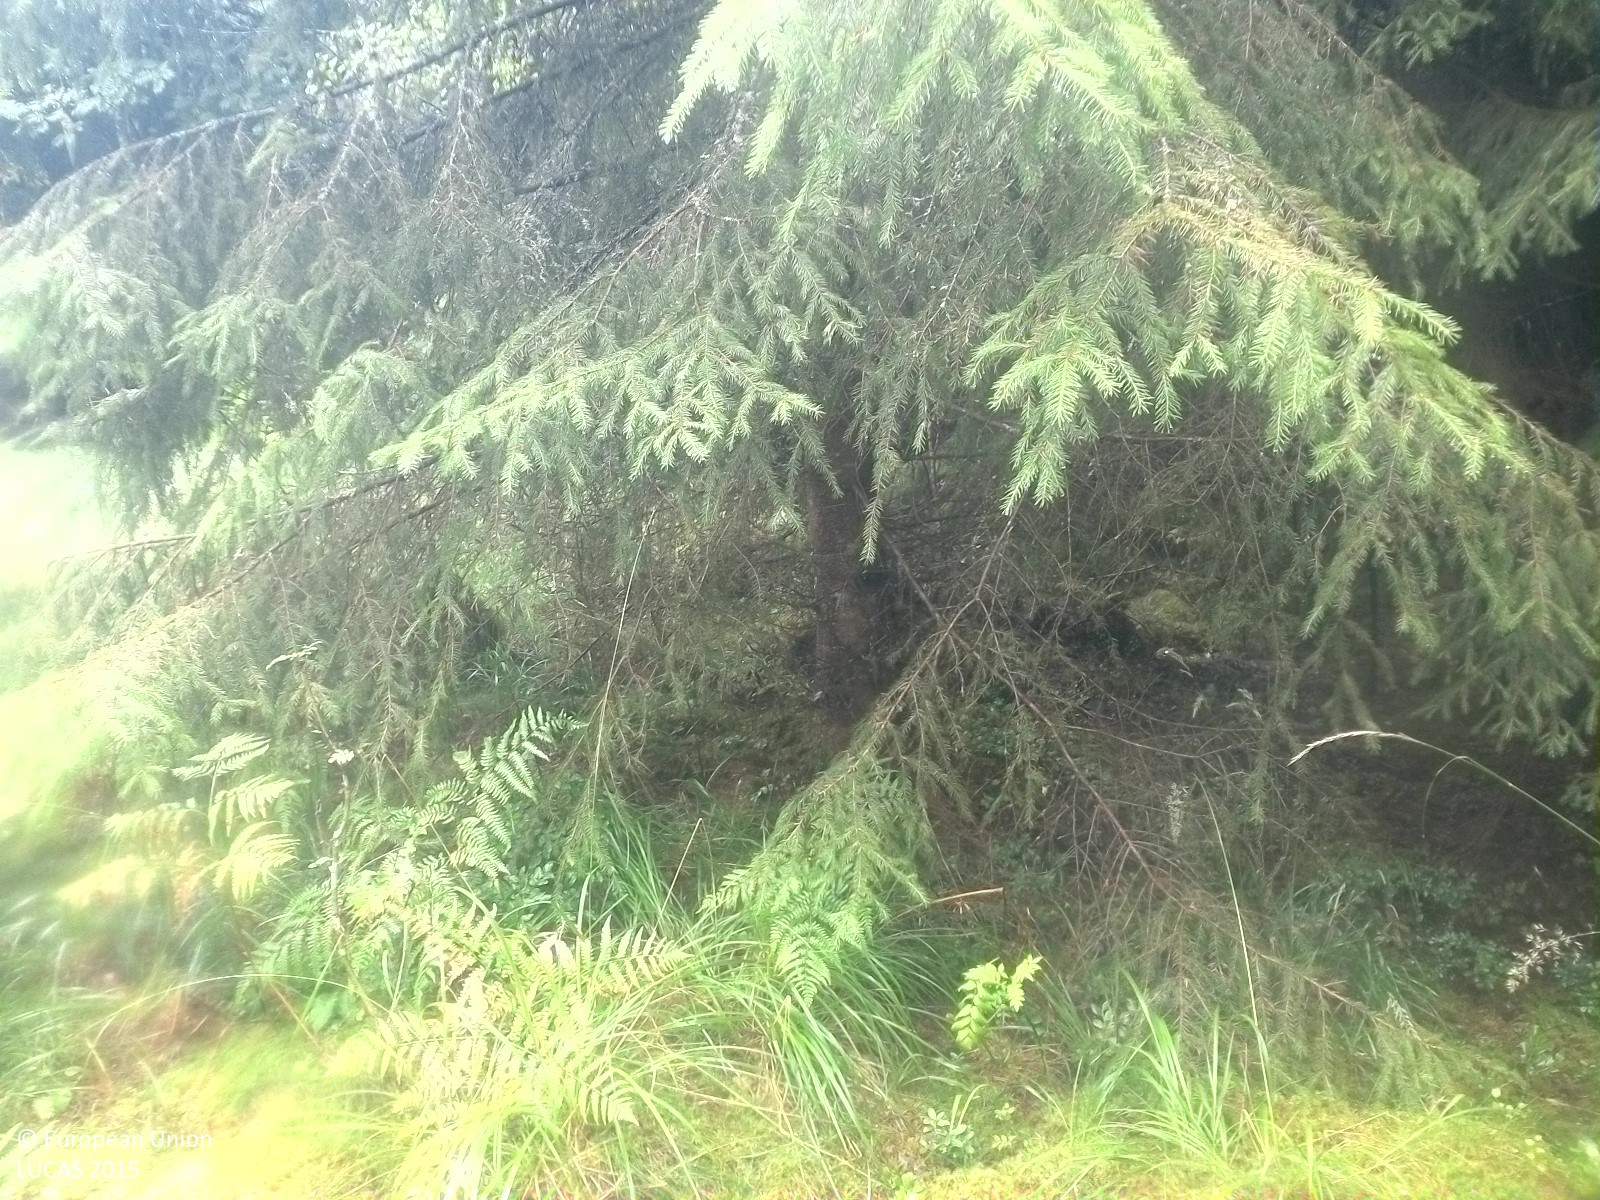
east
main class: Woodland
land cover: Spruce dominated mixed woodland
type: boreal forest
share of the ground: 25 - 50 %
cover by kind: herbaceous plants 55 %, coniferous forest trees 20 %, broadleaved forest trees 15 %, lichens and mosses 10 %
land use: Forestry
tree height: > 5 m
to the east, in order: Spruce dominated mixed woodland; Tracks; Spruce dominated mixed woodland; Broadleaved woodland; Ditches and canals; Grass margins; Paved roads, cycling and walking lanes; Grass margins; Ditches and canals; Grass margins; Fences; Grassland without tree/shrub cover
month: July
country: SE
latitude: 58.8463
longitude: 15.0359
